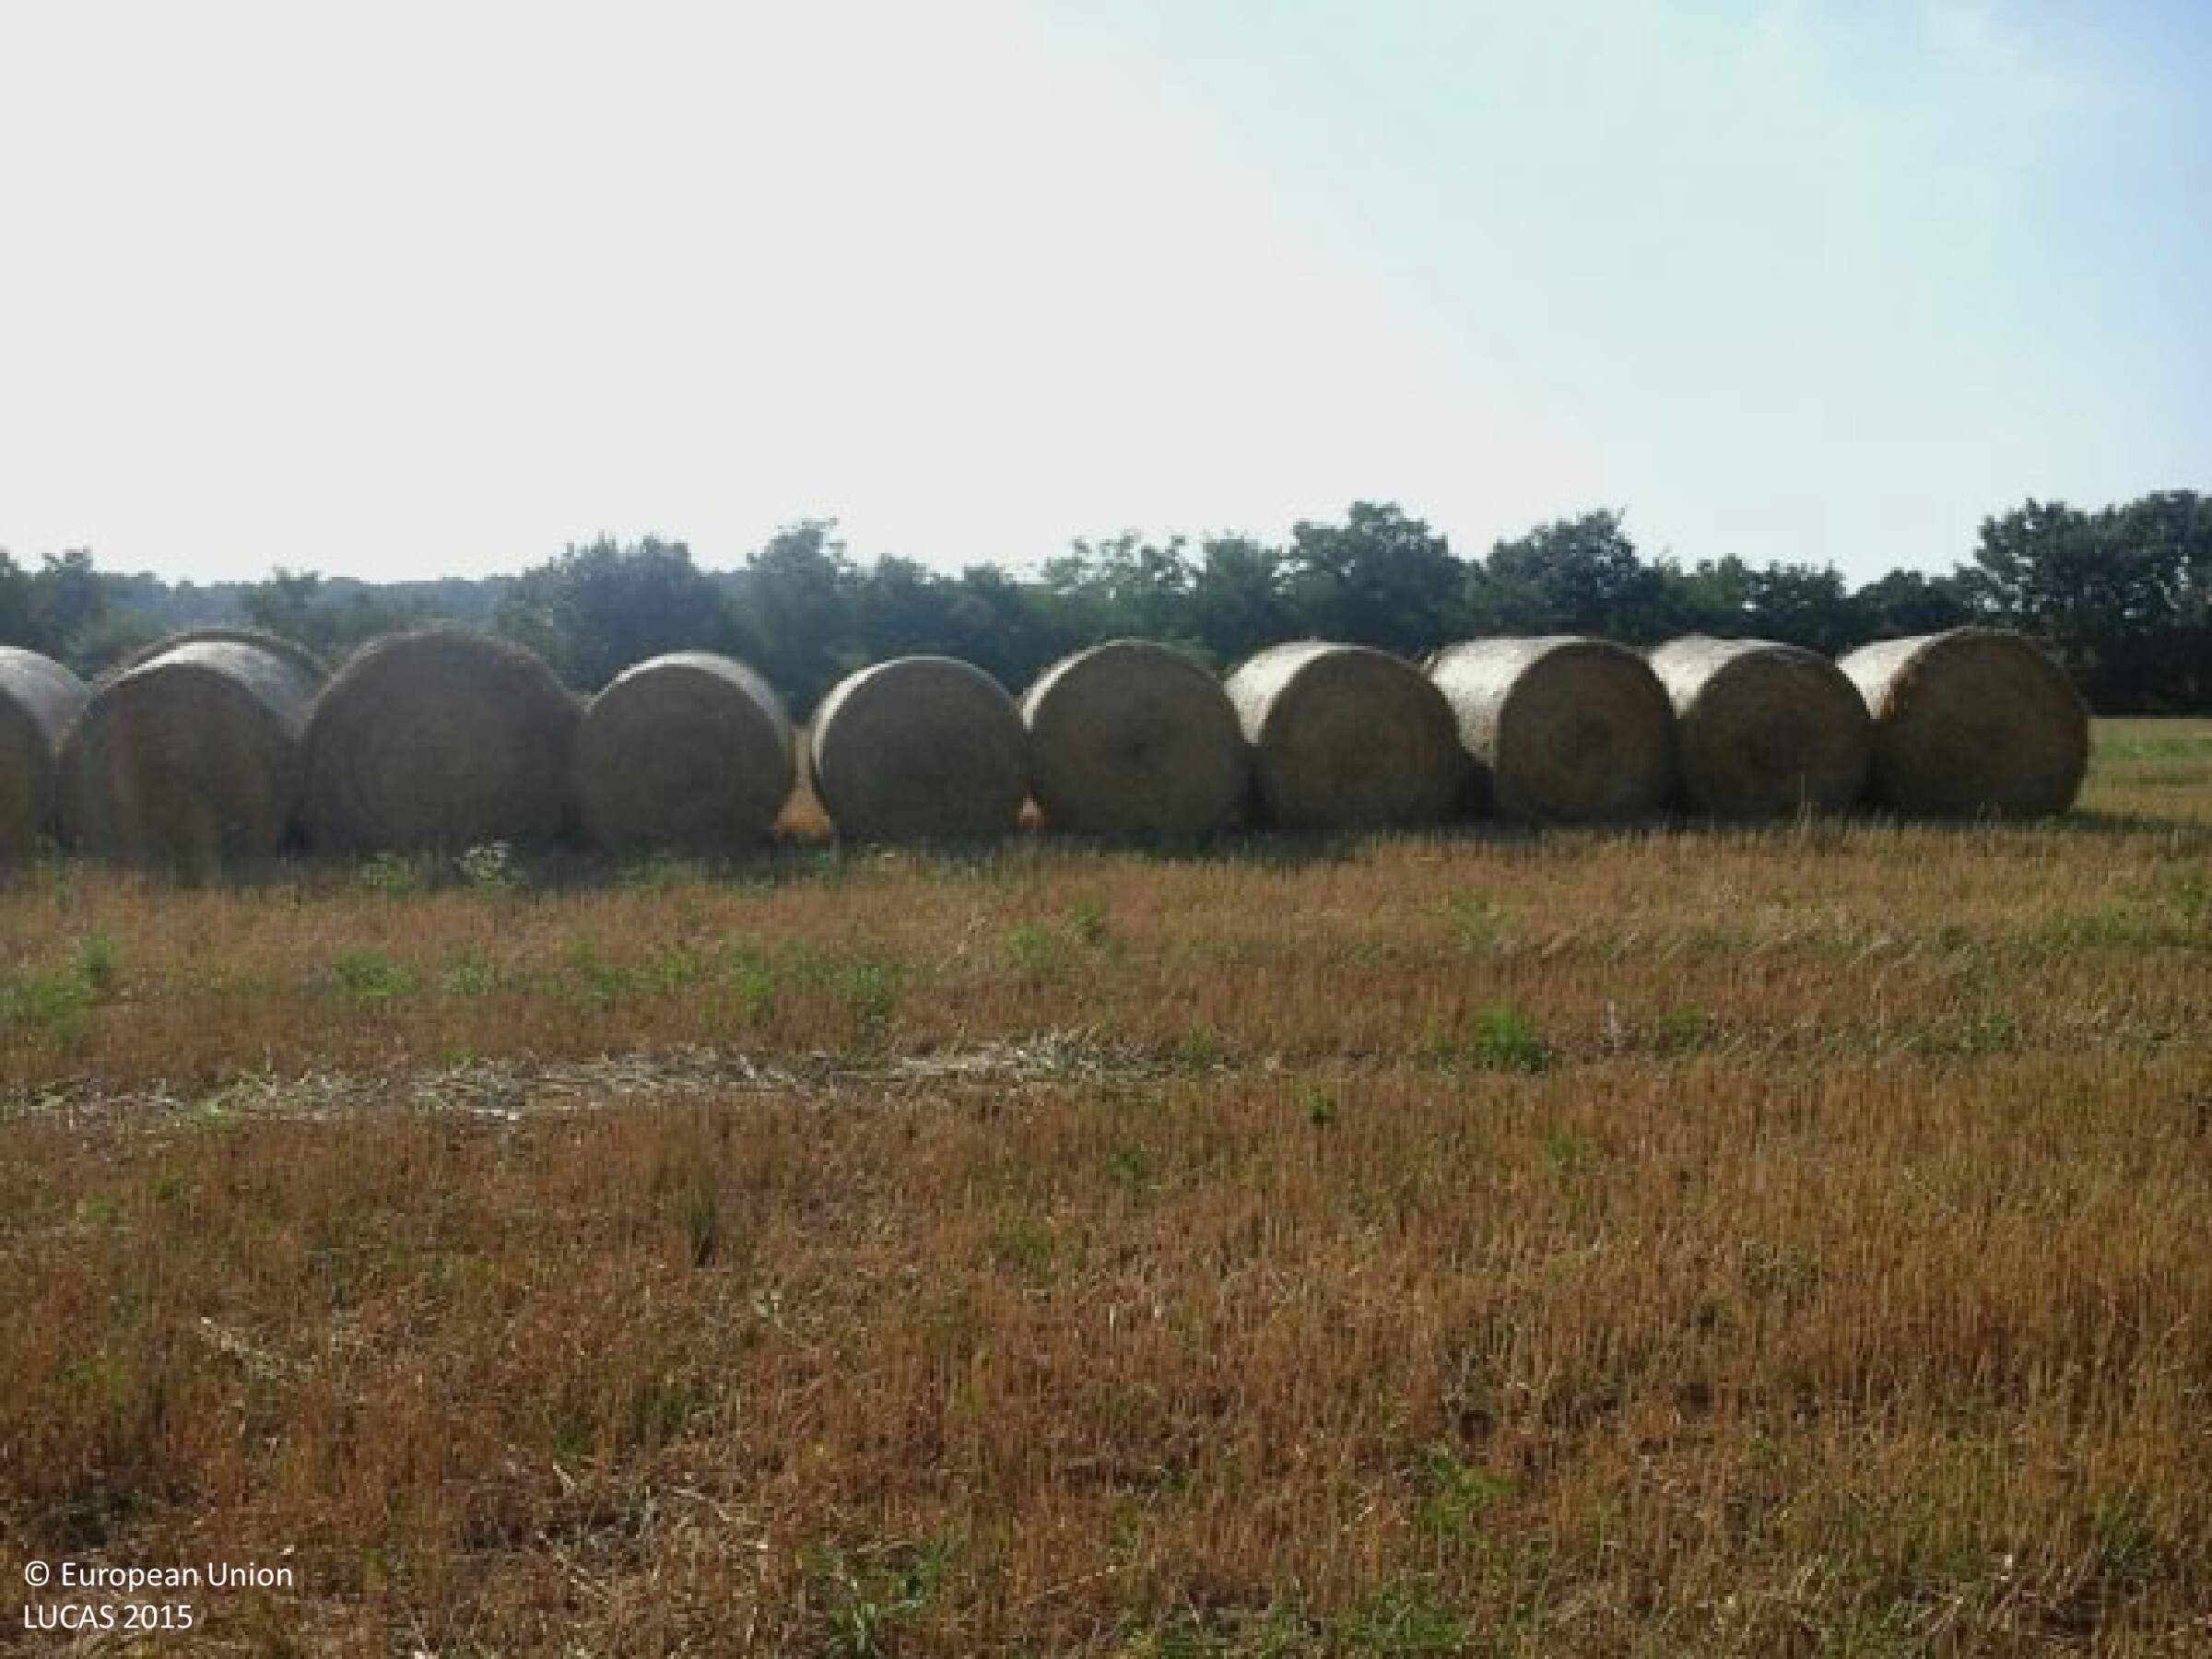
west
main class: Cropland
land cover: Triticale
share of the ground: < 10 %
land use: Agriculture (excluding fallow land and kitchen gardens)
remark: Harvested field
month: August
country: HU
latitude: 46.2854
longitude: 18.0150
